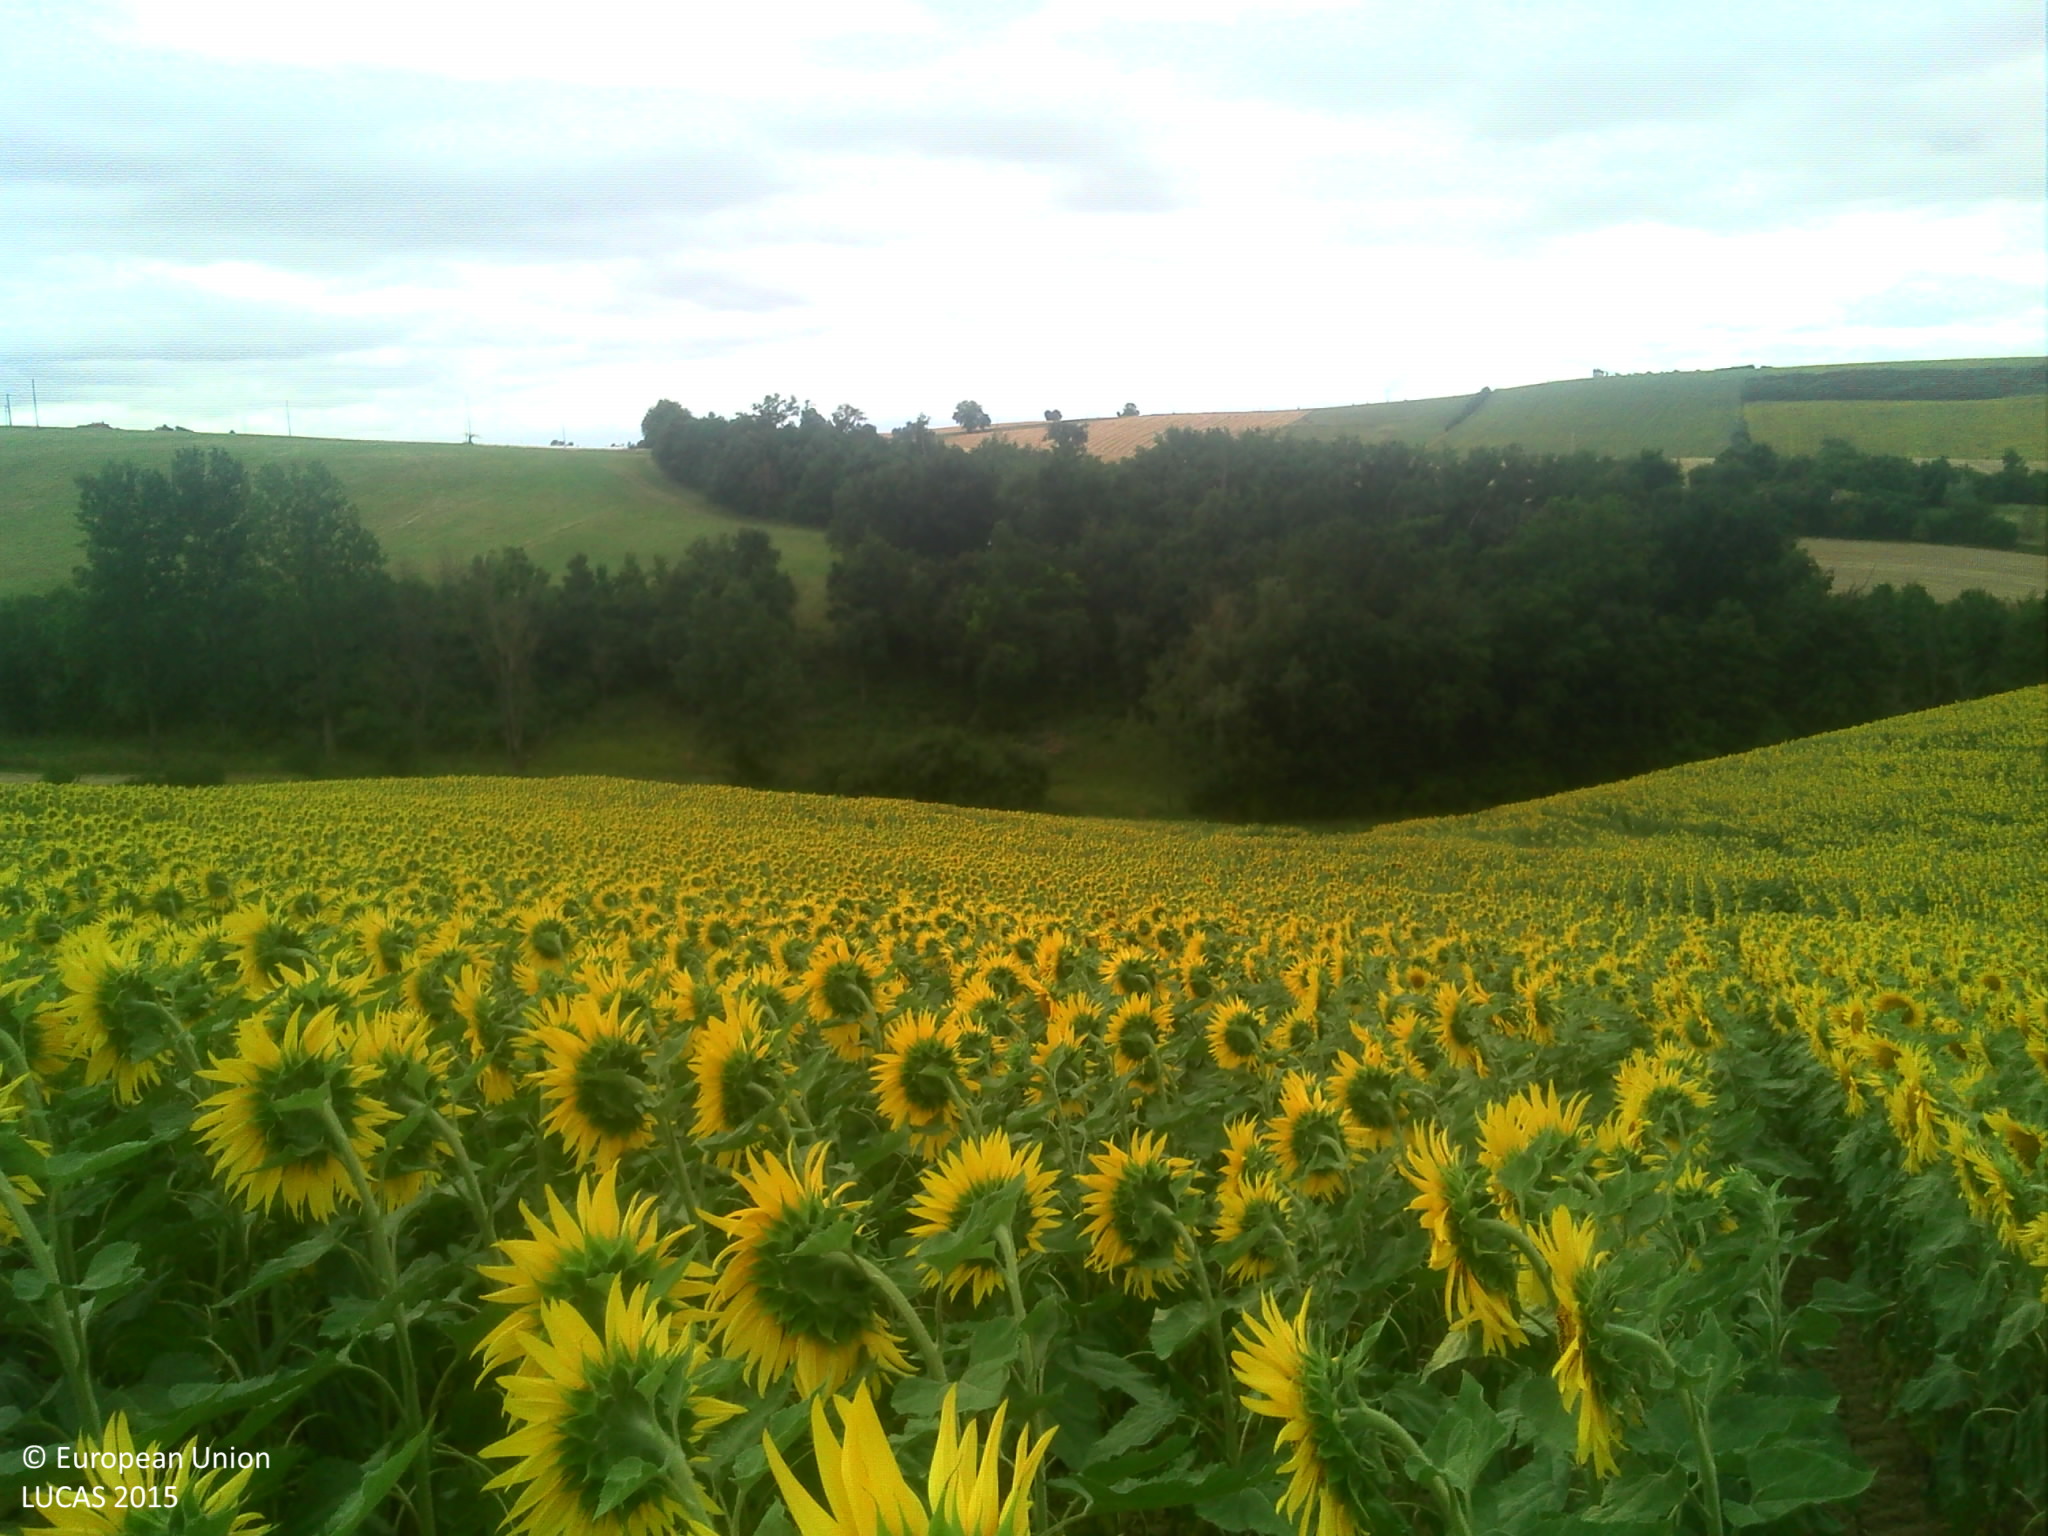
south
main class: Cropland
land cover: Sunflower
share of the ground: > 75 %
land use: Agriculture (excluding fallow land and kitchen gardens)
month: July
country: FR
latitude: 43.3186
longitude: 1.3600
